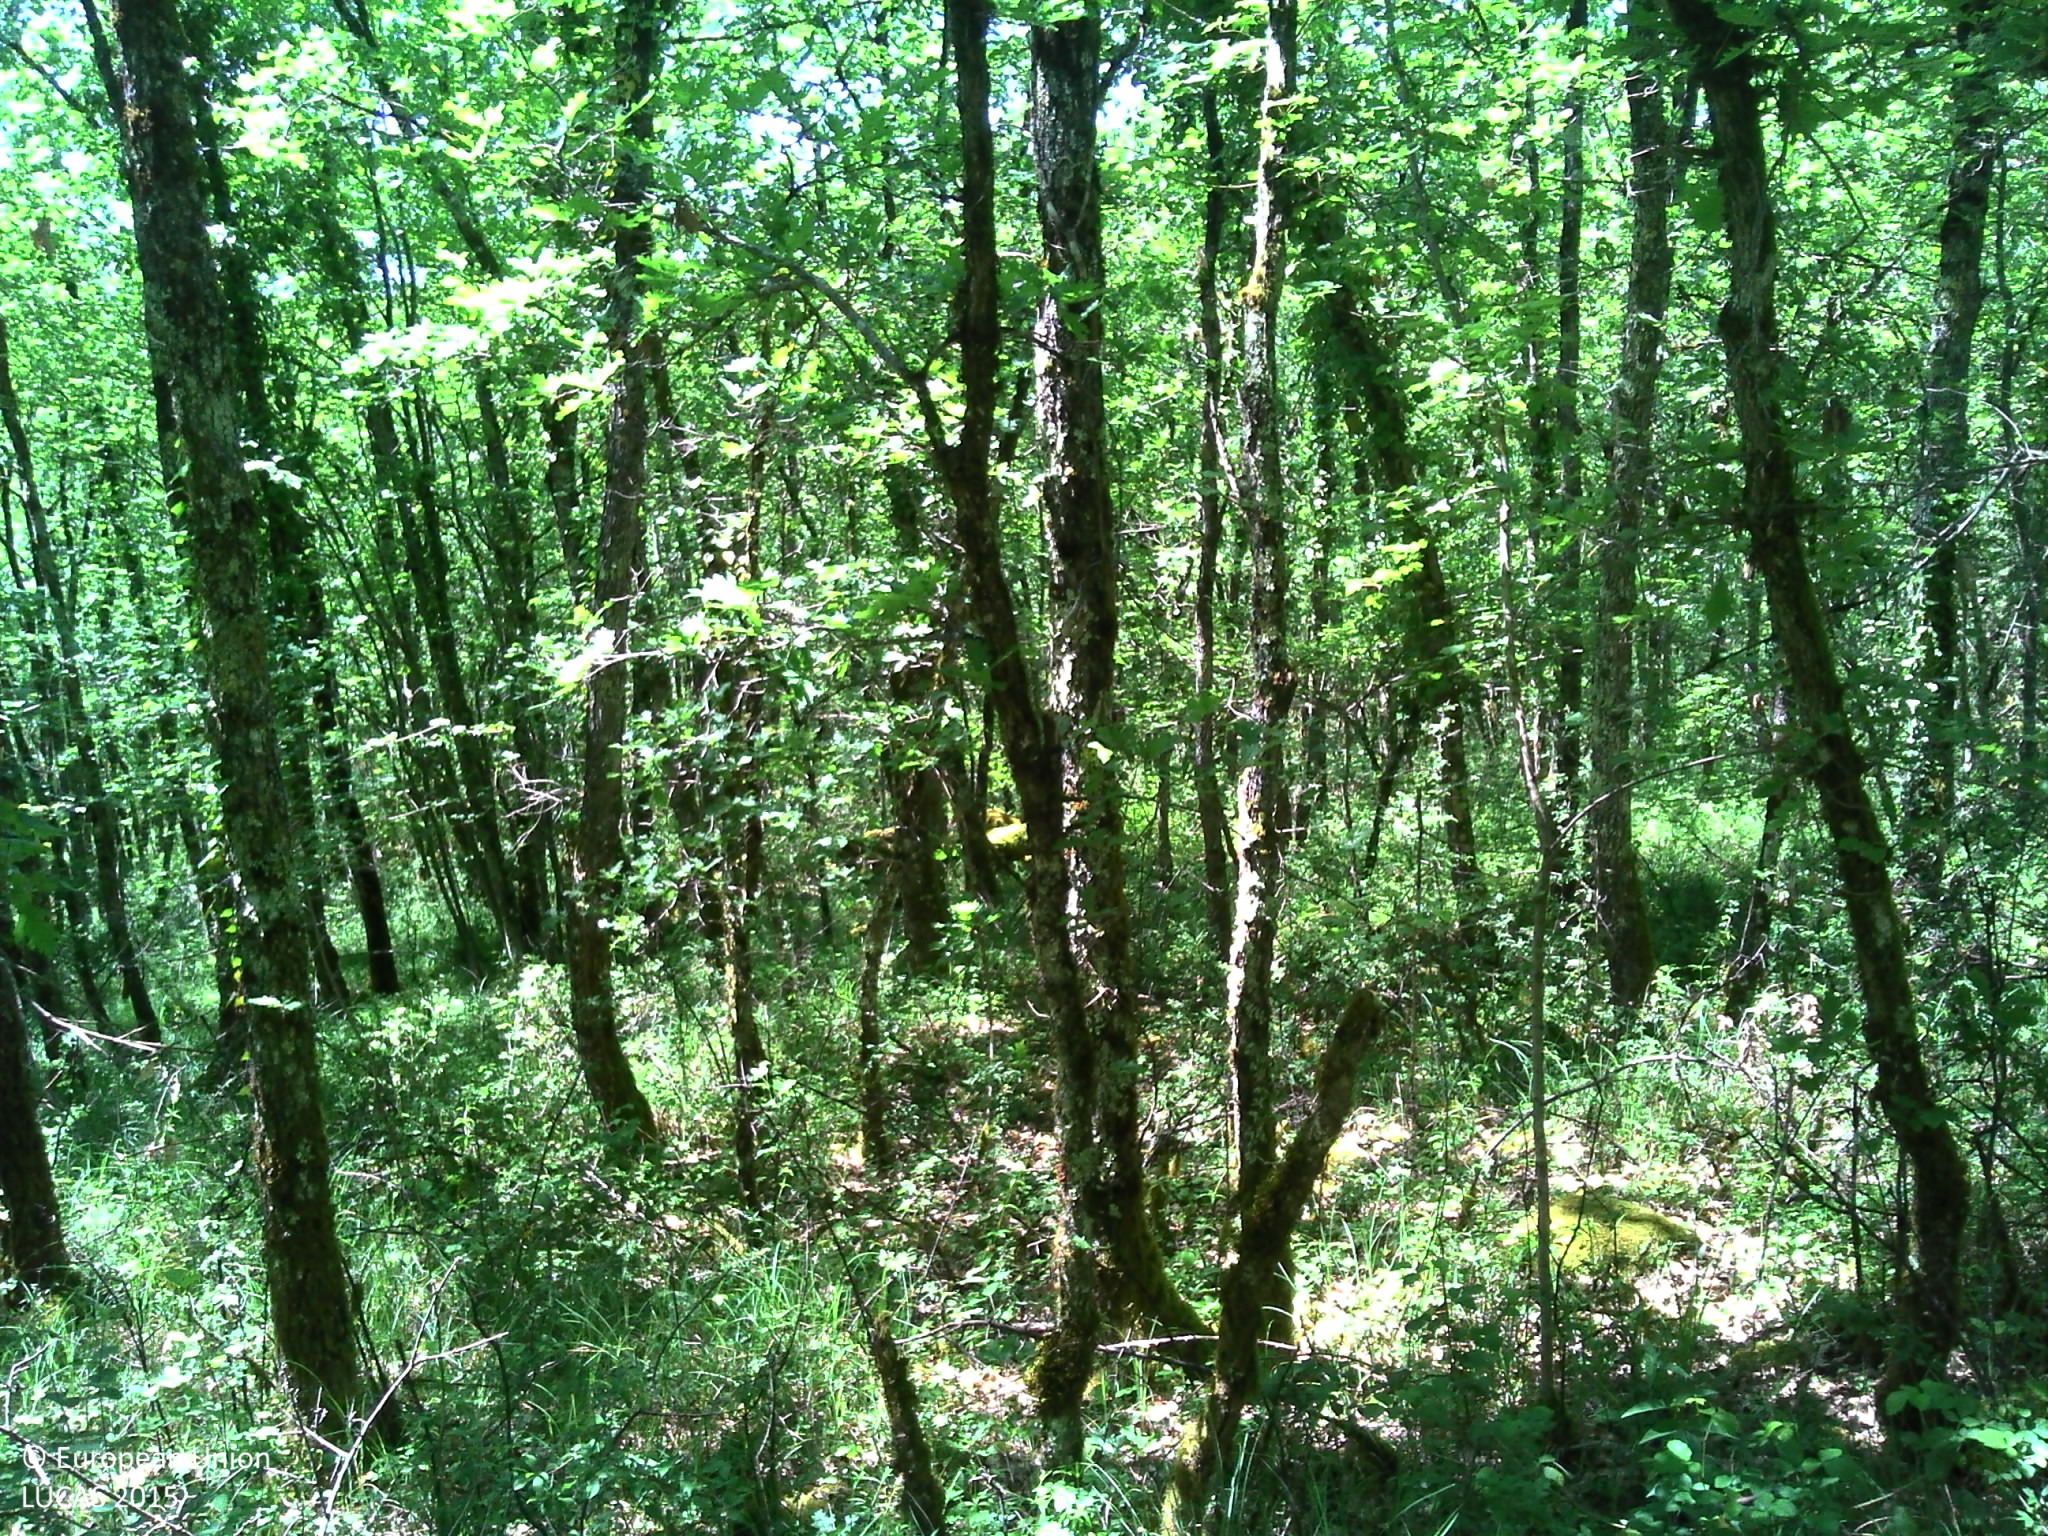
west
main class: Woodland
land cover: Broadleaved woodland
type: thermophilous deciduous forest
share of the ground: > 75 %
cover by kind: broadleaved forest trees 95 %, herbaceous plants 5 %
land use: Forestry
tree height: > 5 m
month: May
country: FR
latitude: 44.5433
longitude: 1.9322
